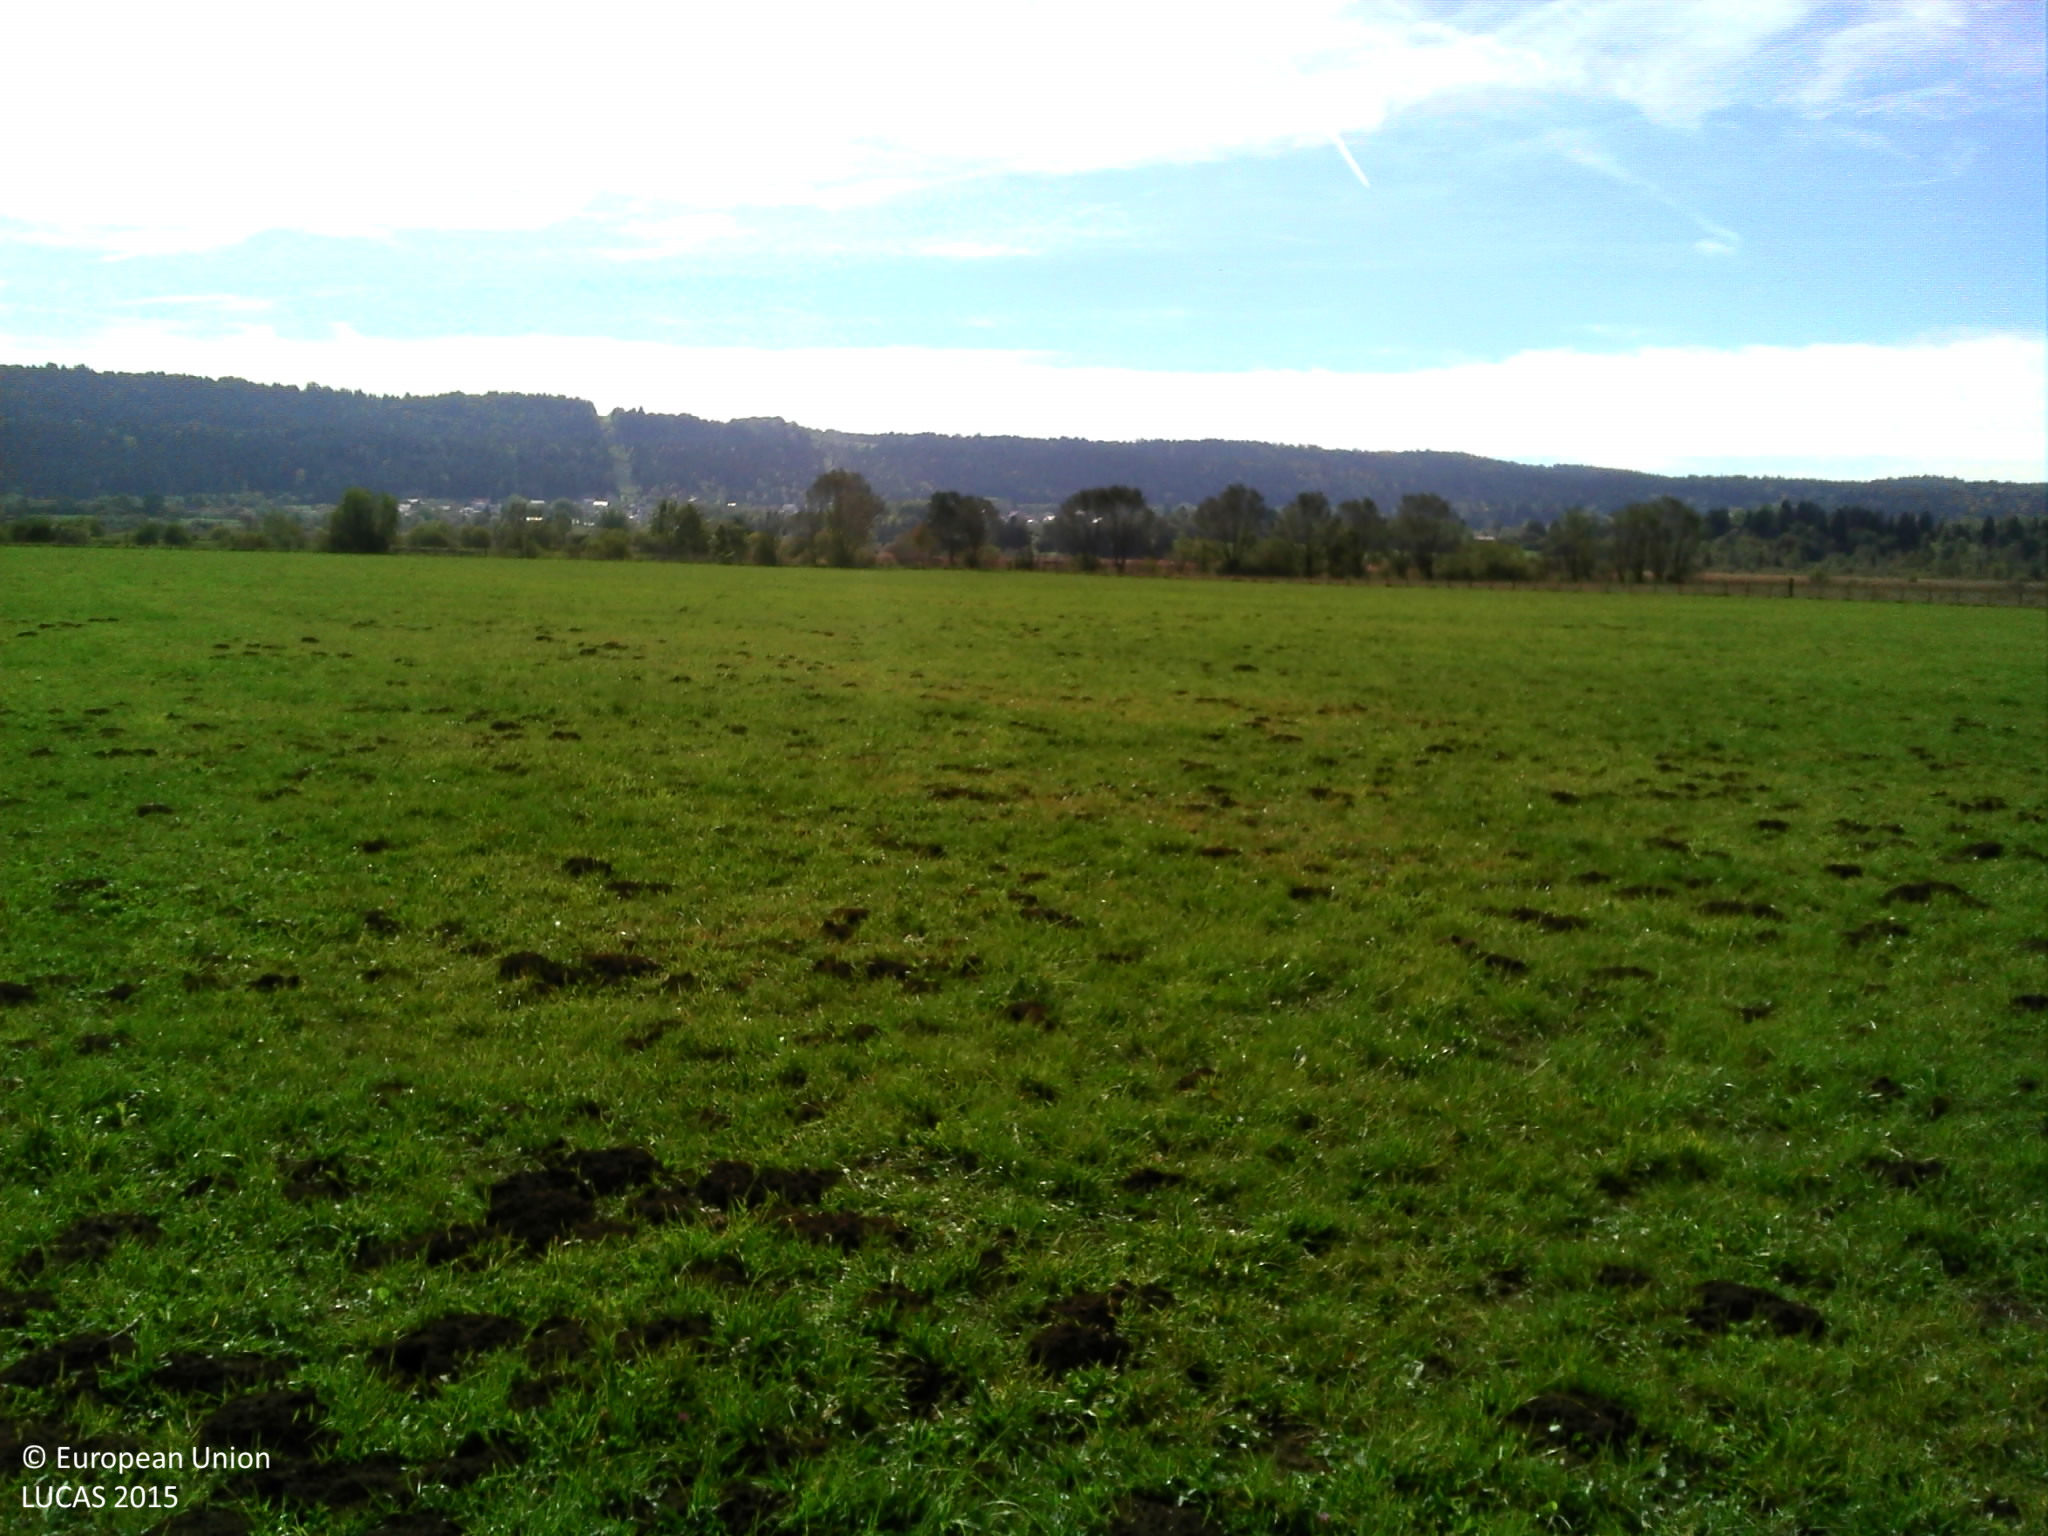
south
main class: Grassland
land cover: Grassland without tree/shrub cover
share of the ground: > 75 %
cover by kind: herbaceous plants 100 %
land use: Agriculture (excluding fallow land and kitchen gardens)
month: October
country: FR
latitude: 46.9006
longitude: 6.3137
